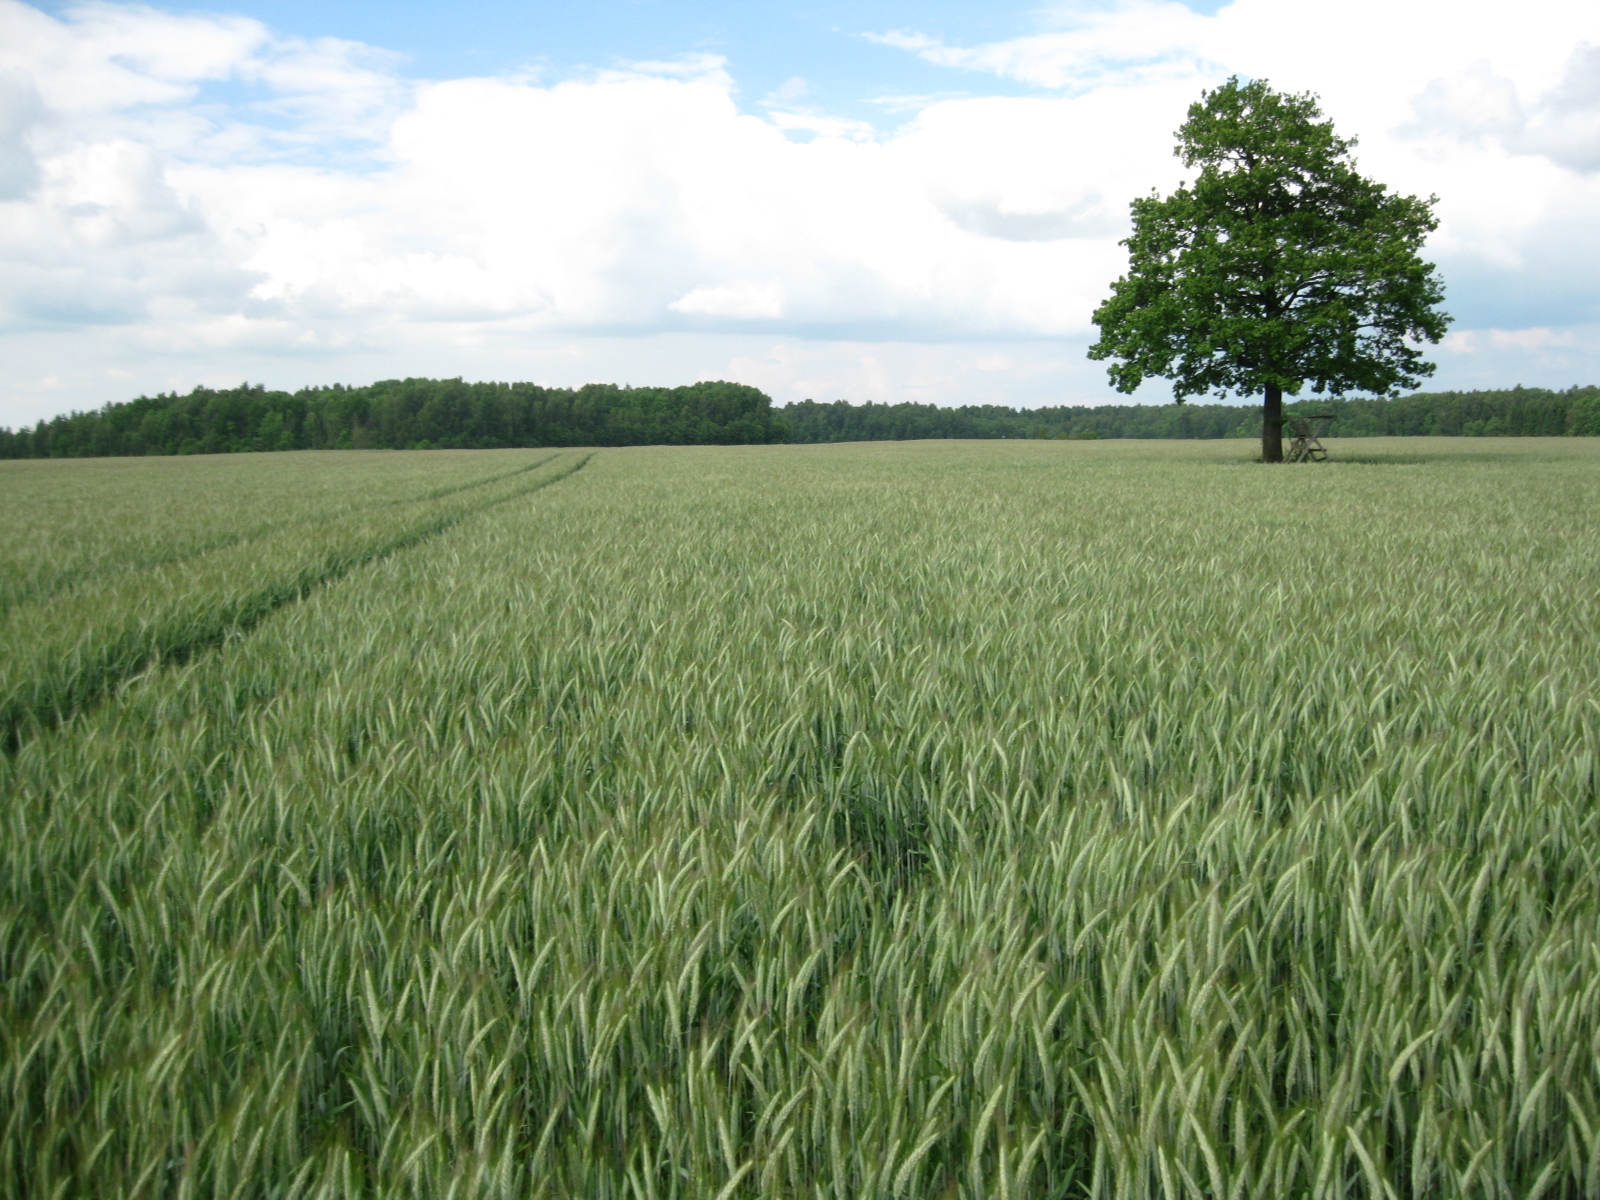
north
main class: Cropland
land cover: Triticale
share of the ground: > 75 %
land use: Agriculture (excluding fallow land and kitchen gardens)
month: June
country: LT
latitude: 55.6074
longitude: 23.9132
